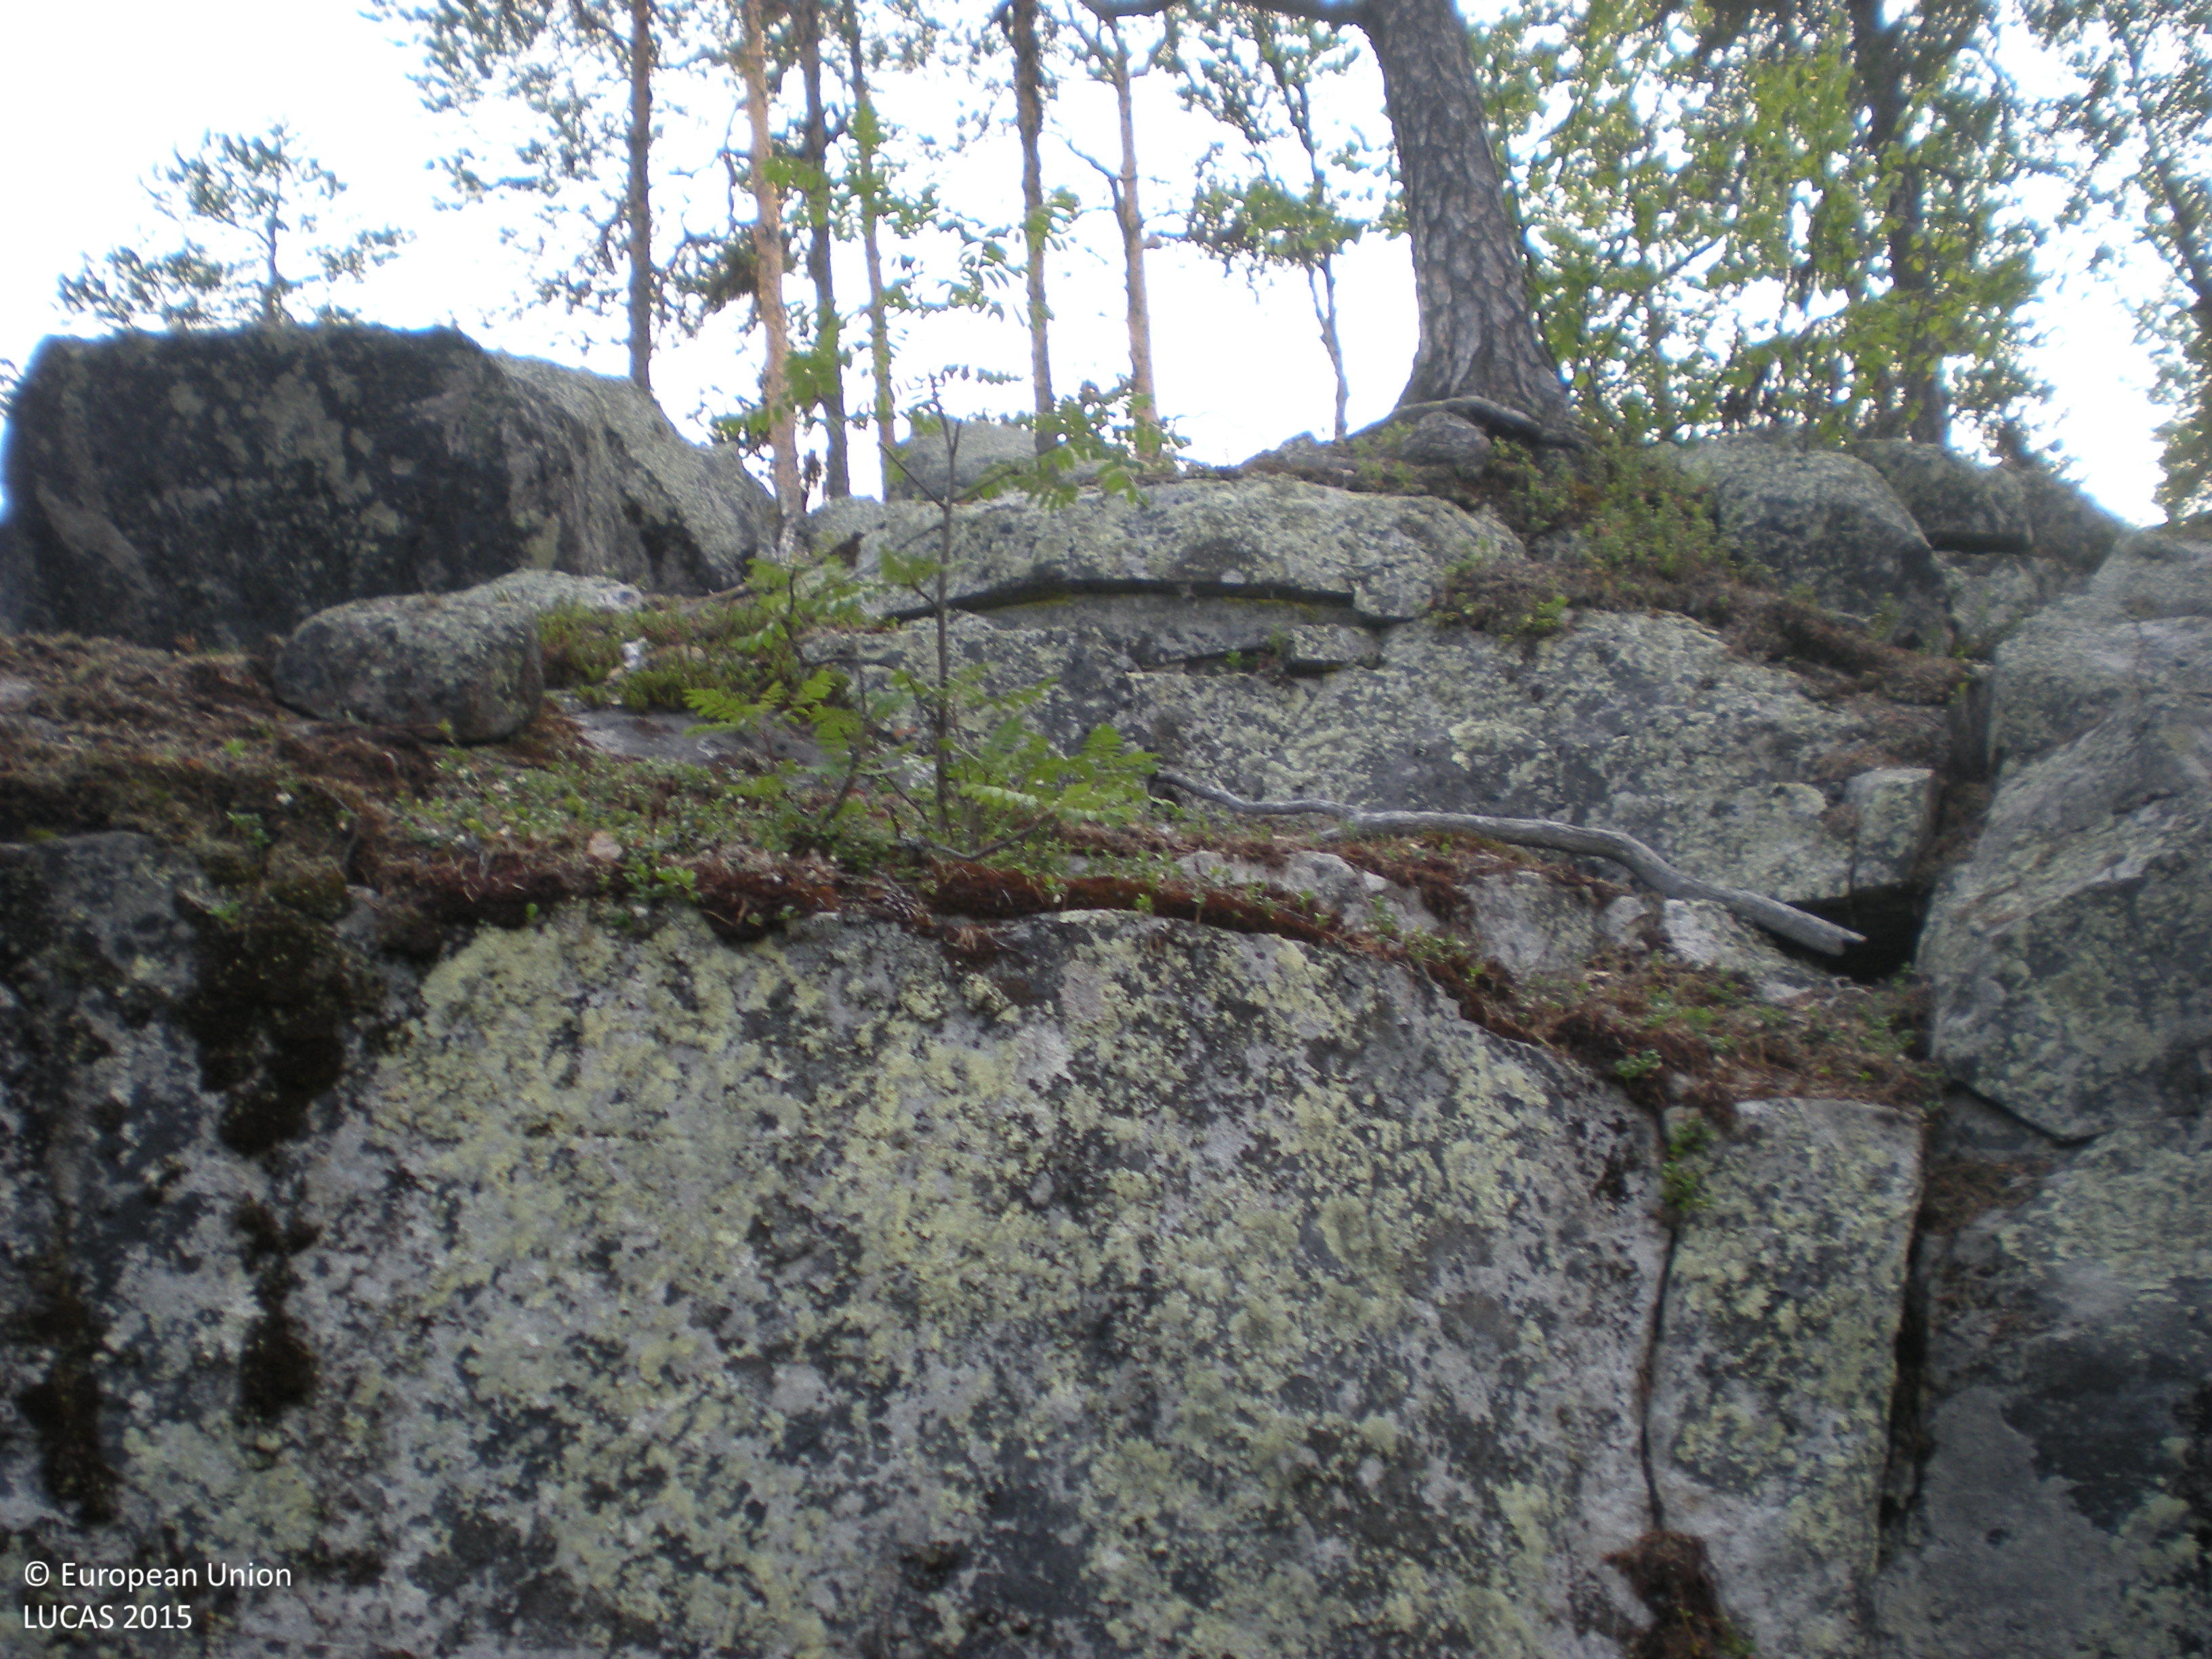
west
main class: Woodland
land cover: Pine dominated coniferous woodland
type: boreal forest
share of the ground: 10 - 25 %
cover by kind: consolidated bare surface 70 %, coniferous forest trees 15 %, shrubs 10 %, broadleaved forest trees 5 %
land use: Semi-natural and natural areas not in use
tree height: > 5 m
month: July
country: SE
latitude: 65.6923
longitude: 17.0781
